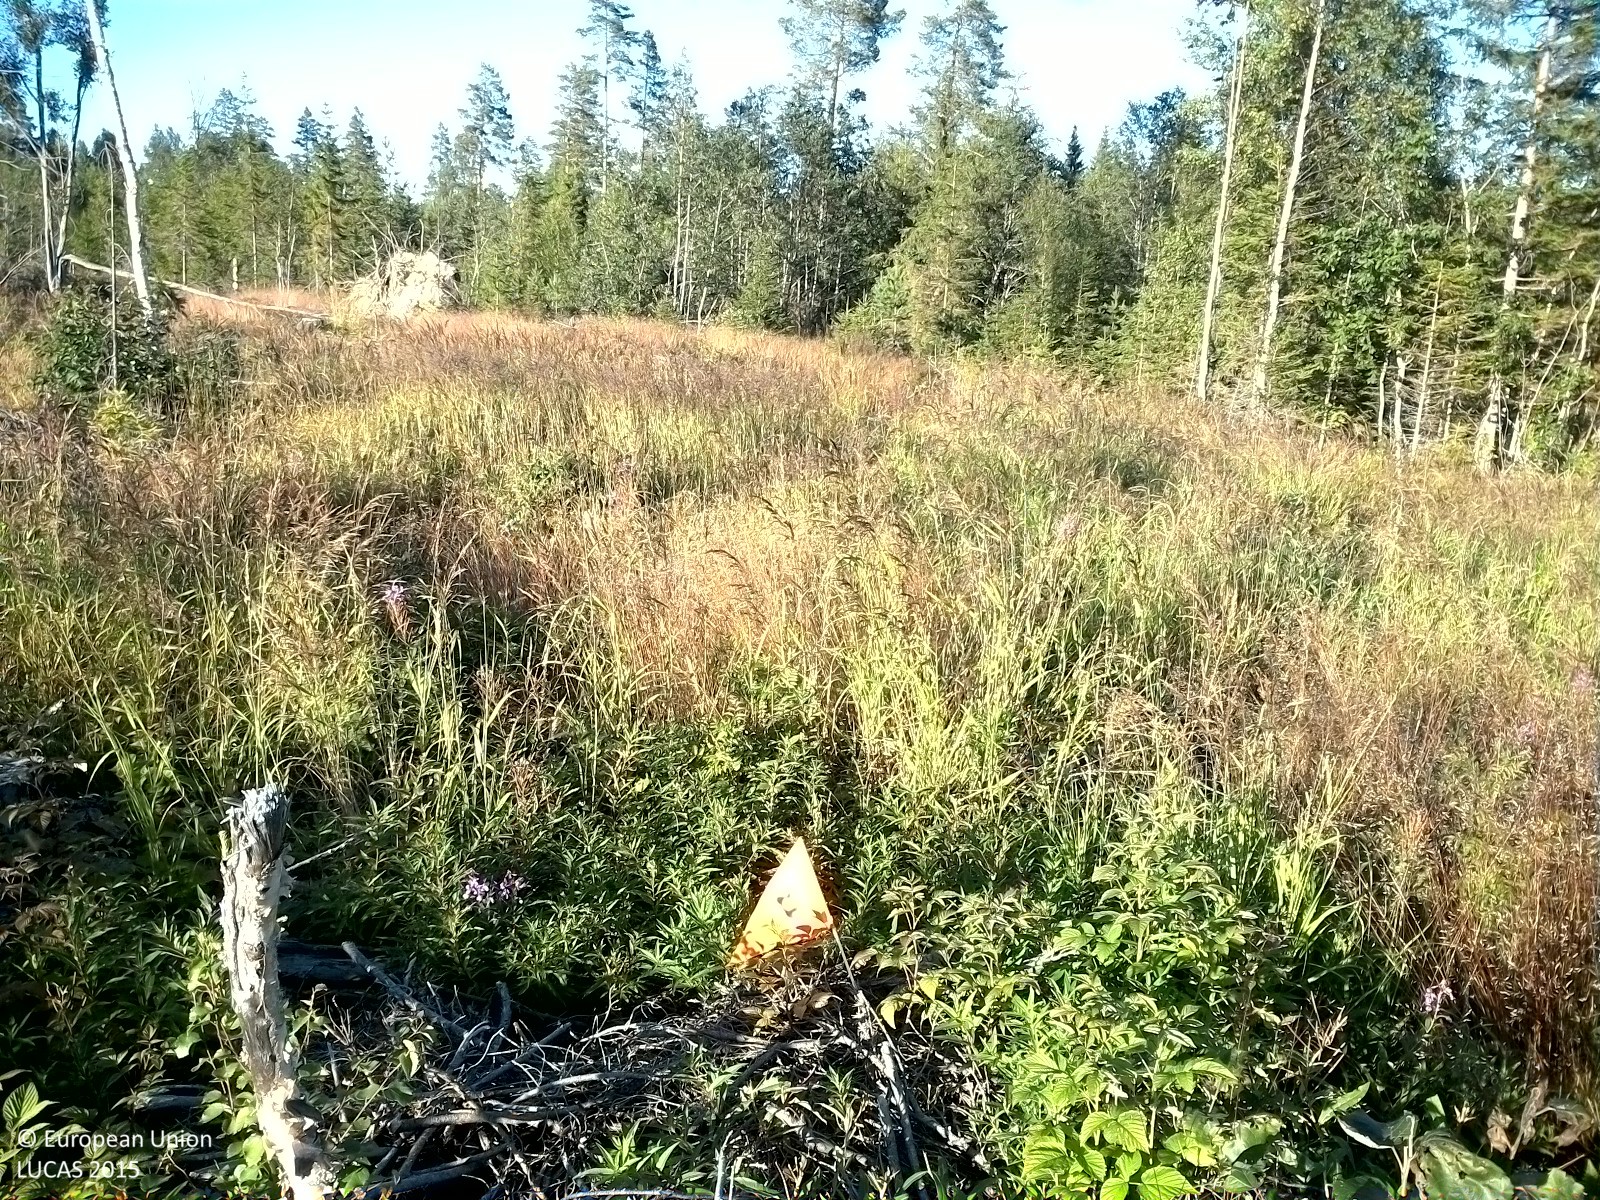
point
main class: Grassland
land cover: Grassland with sparse tree/shrub cover
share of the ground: > 75 %
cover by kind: herbaceous plants 90 %, broadleaved forest trees 5 %, unconsolidated bare surface 5 %
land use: Forestry
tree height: < 5 m
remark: Clear cut
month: August
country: SE
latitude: 62.3654
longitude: 16.4539
